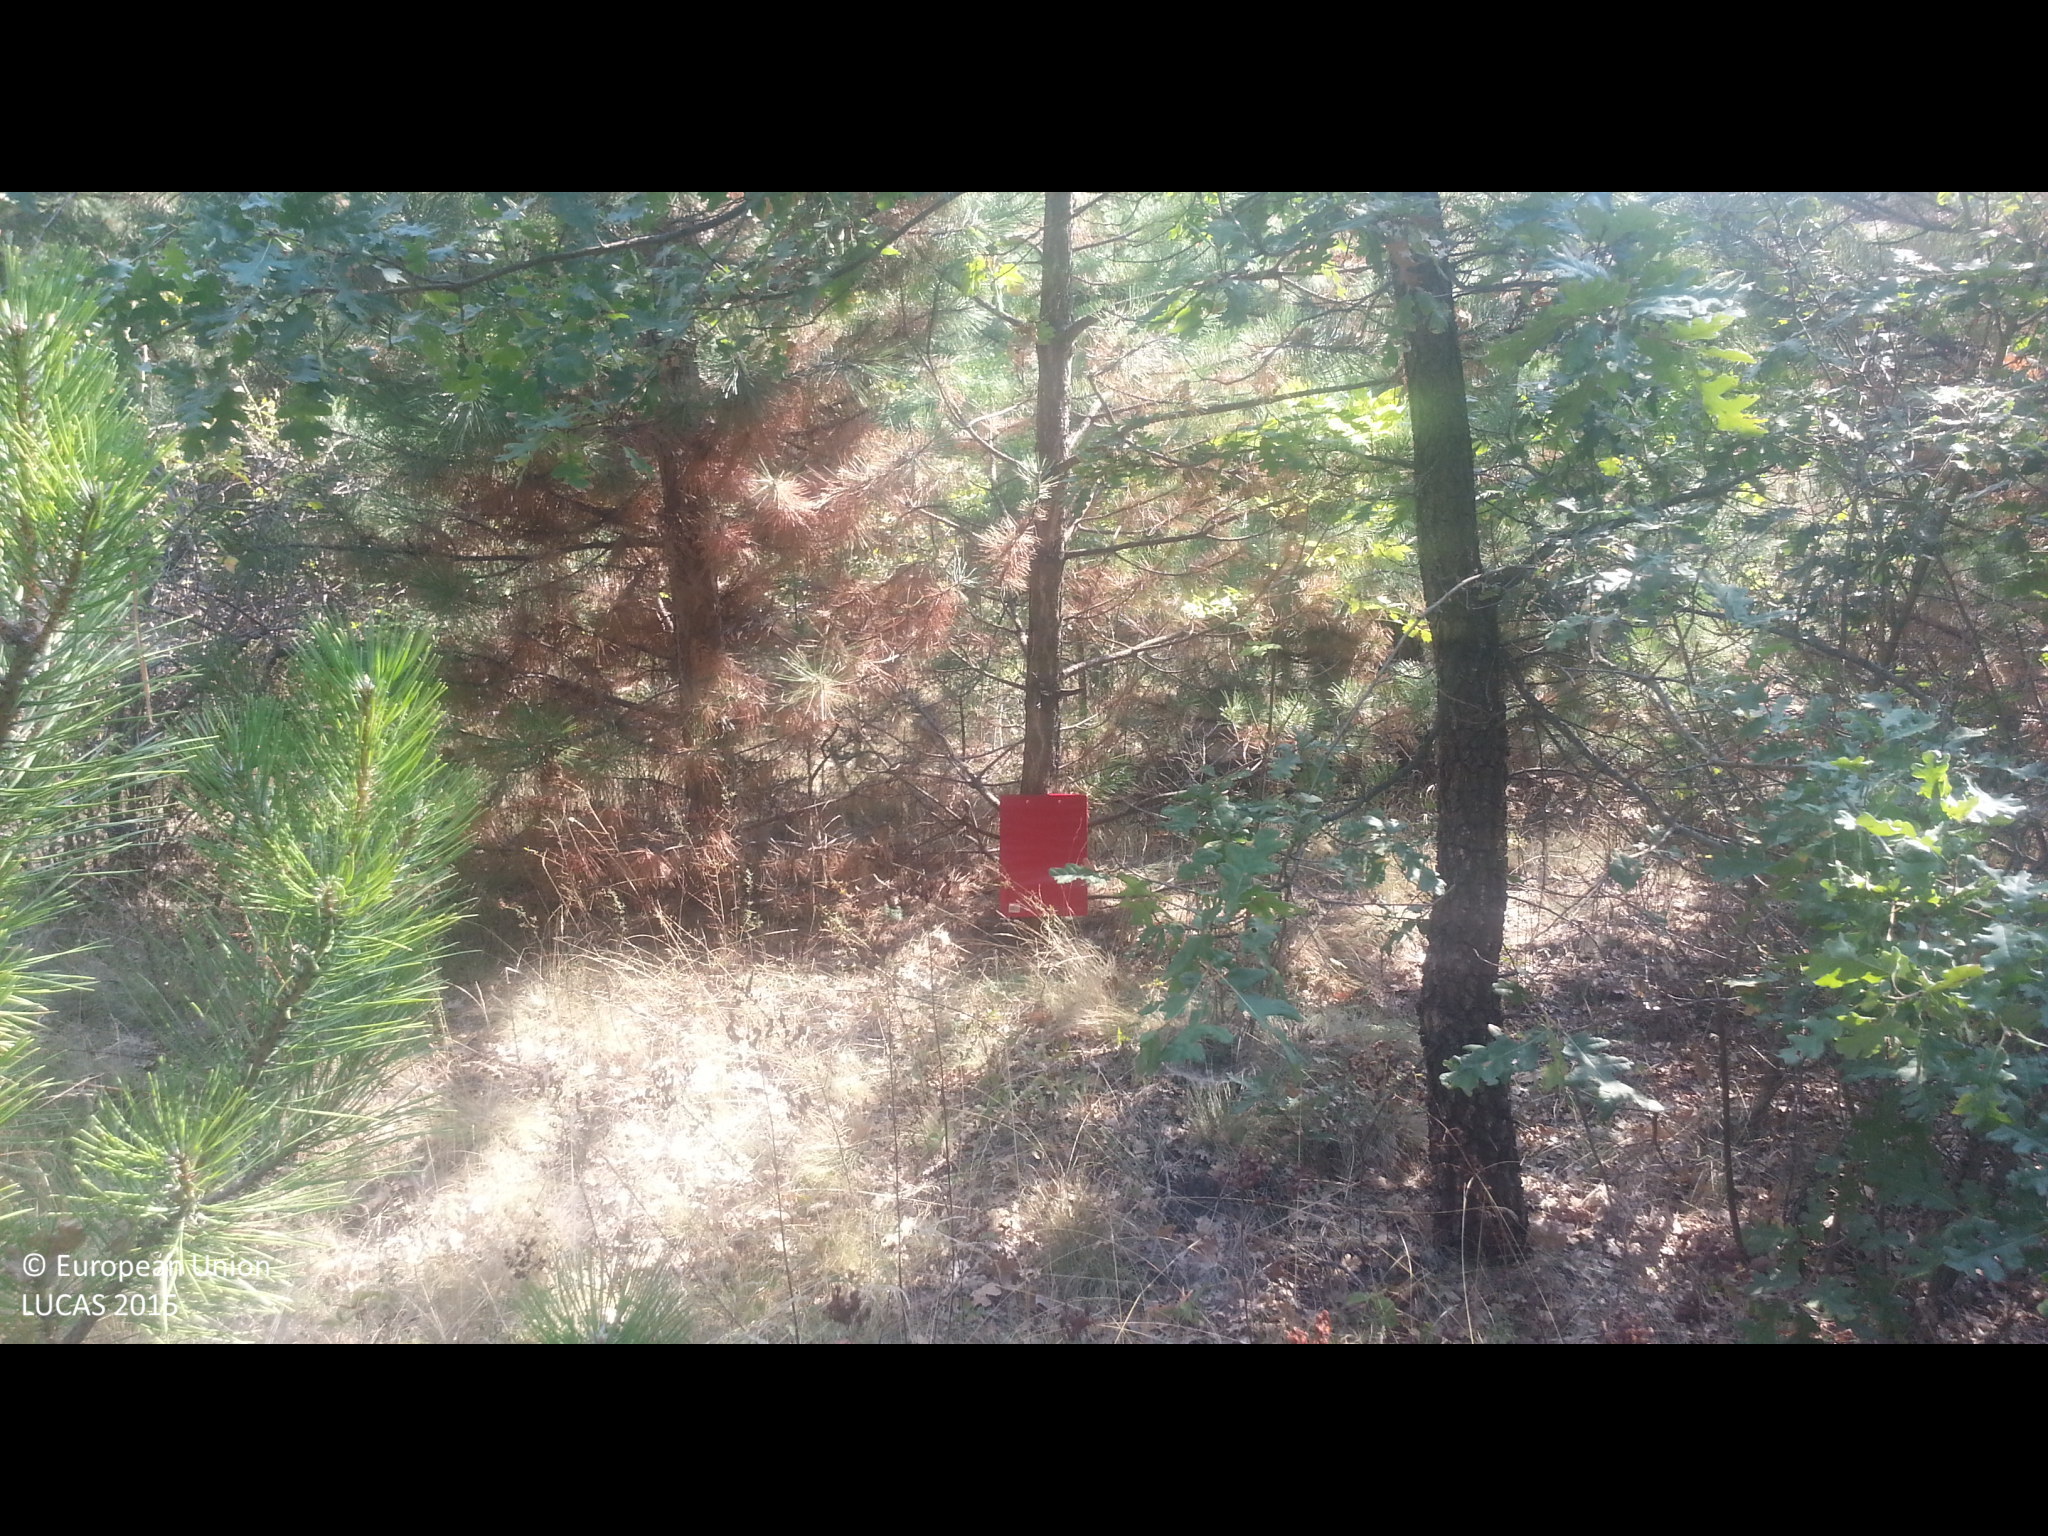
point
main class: Woodland
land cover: Other mixed woodland
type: hemiboreal forest and nemoral coniferous forest and mixed broadleaved-coniferous forest
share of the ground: > 75 %
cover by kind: coniferous forest trees 75 %, broadleaved forest trees 25 %
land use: Forestry
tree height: < 5 m
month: August
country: BG
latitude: 42.3680
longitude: 23.0814
